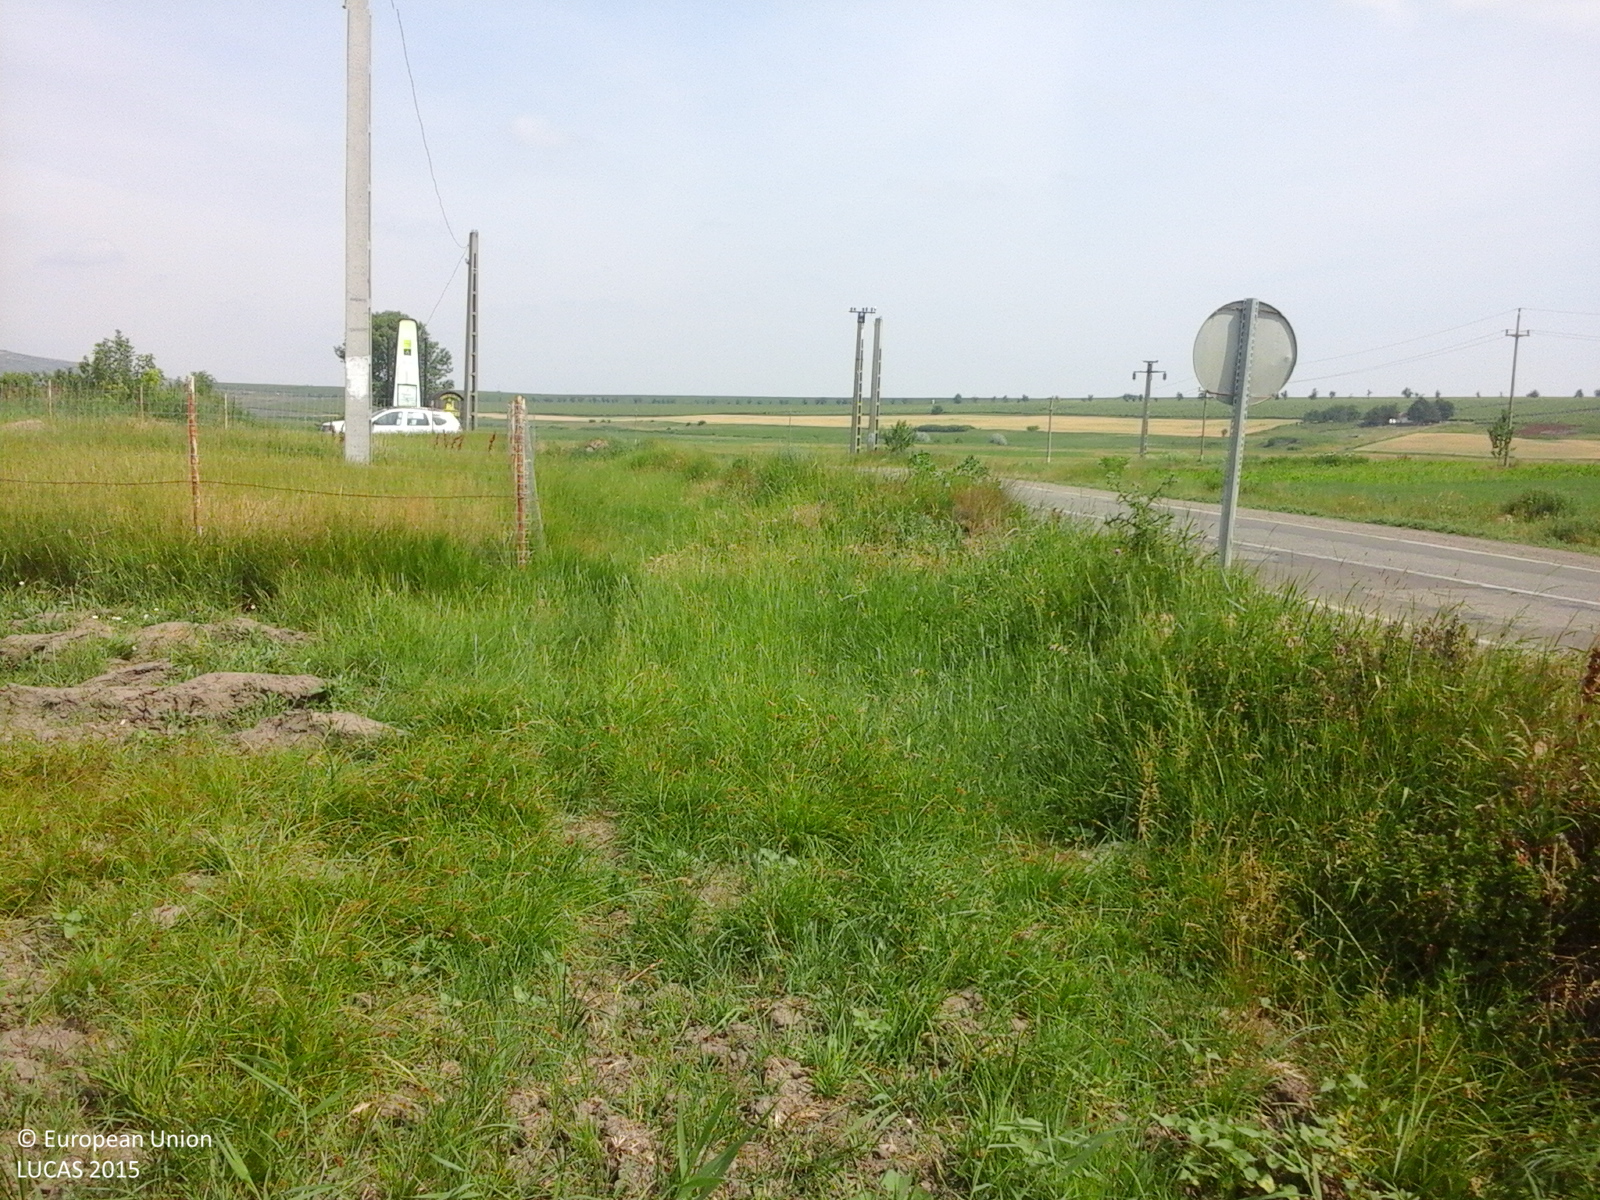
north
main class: Cropland
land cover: Maize
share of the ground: 10 - 25 %
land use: Agriculture (excluding fallow land and kitchen gardens)
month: June
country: RO
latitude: 47.3570
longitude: 26.9546
